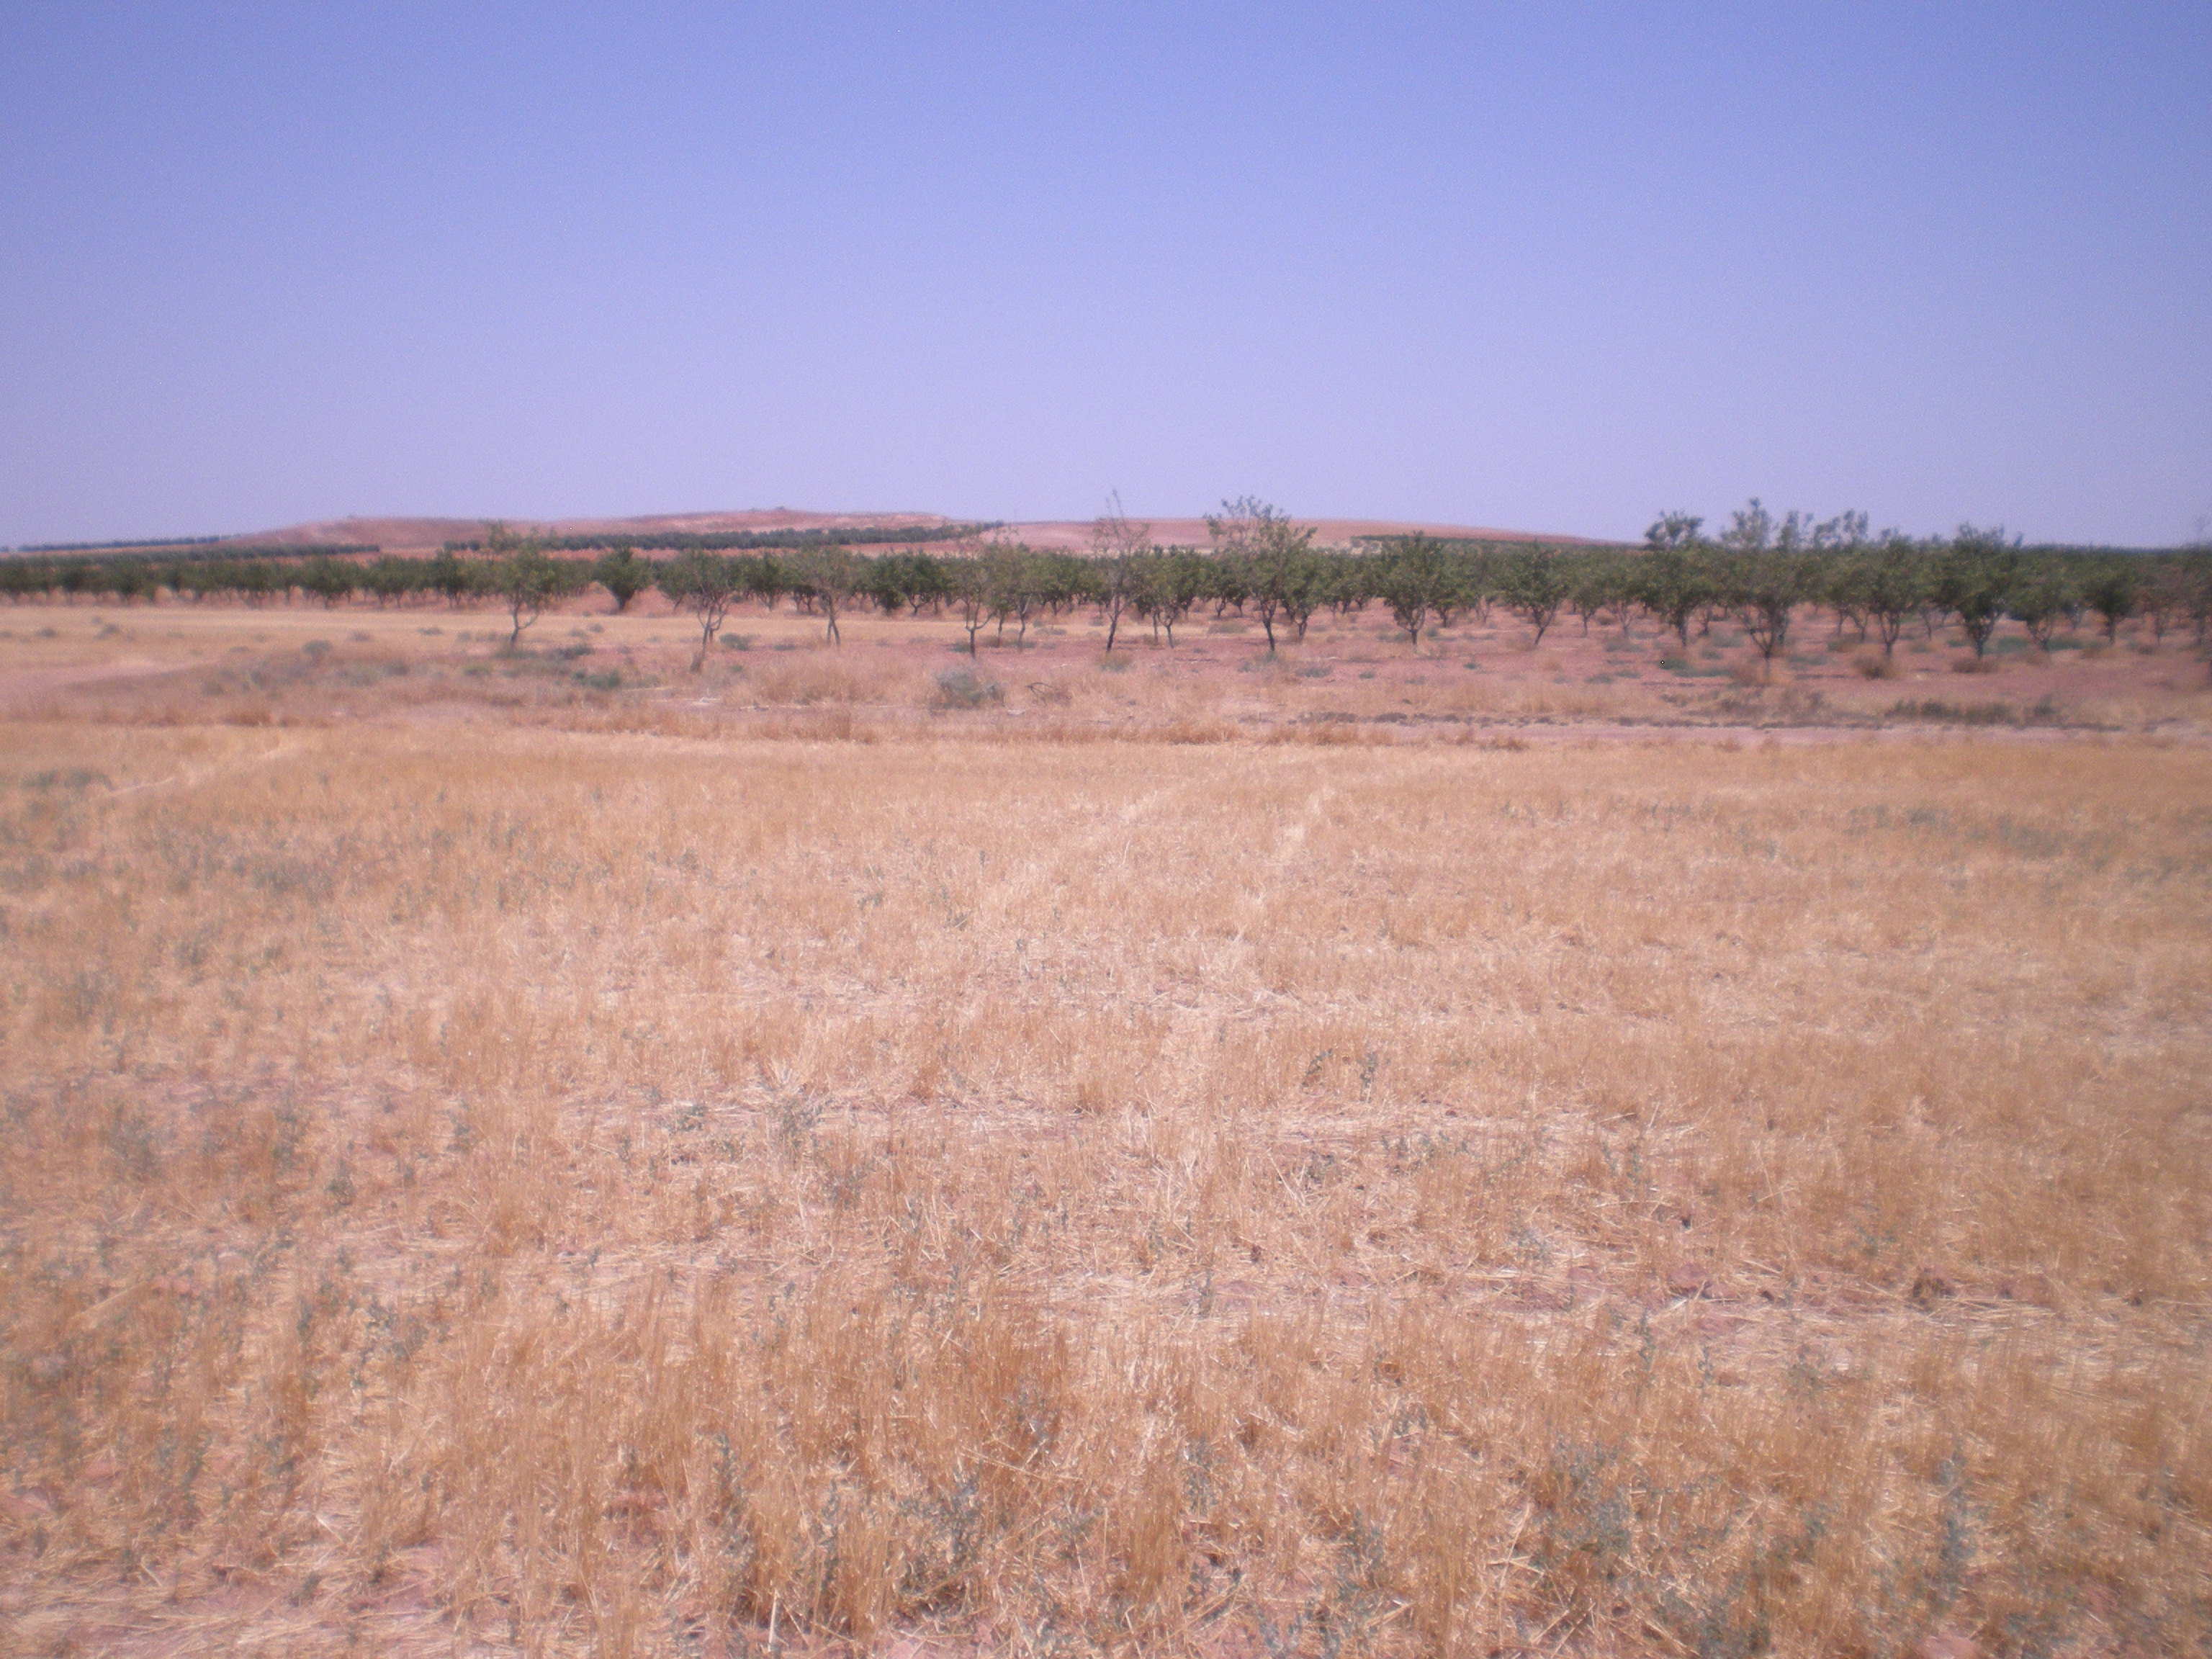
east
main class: Cropland
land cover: Barley
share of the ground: < 10 %
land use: Agriculture (excluding fallow land and kitchen gardens)
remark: Harvested field
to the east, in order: Barley; Grass margins; Tracks; Grass margins; Grassland without tree/shrub cover; Nuts trees; Grass margins; Tracks; Grass margins; Barley; Grass margins; Nuts trees
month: July
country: ES
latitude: 39.3953
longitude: -3.2908
